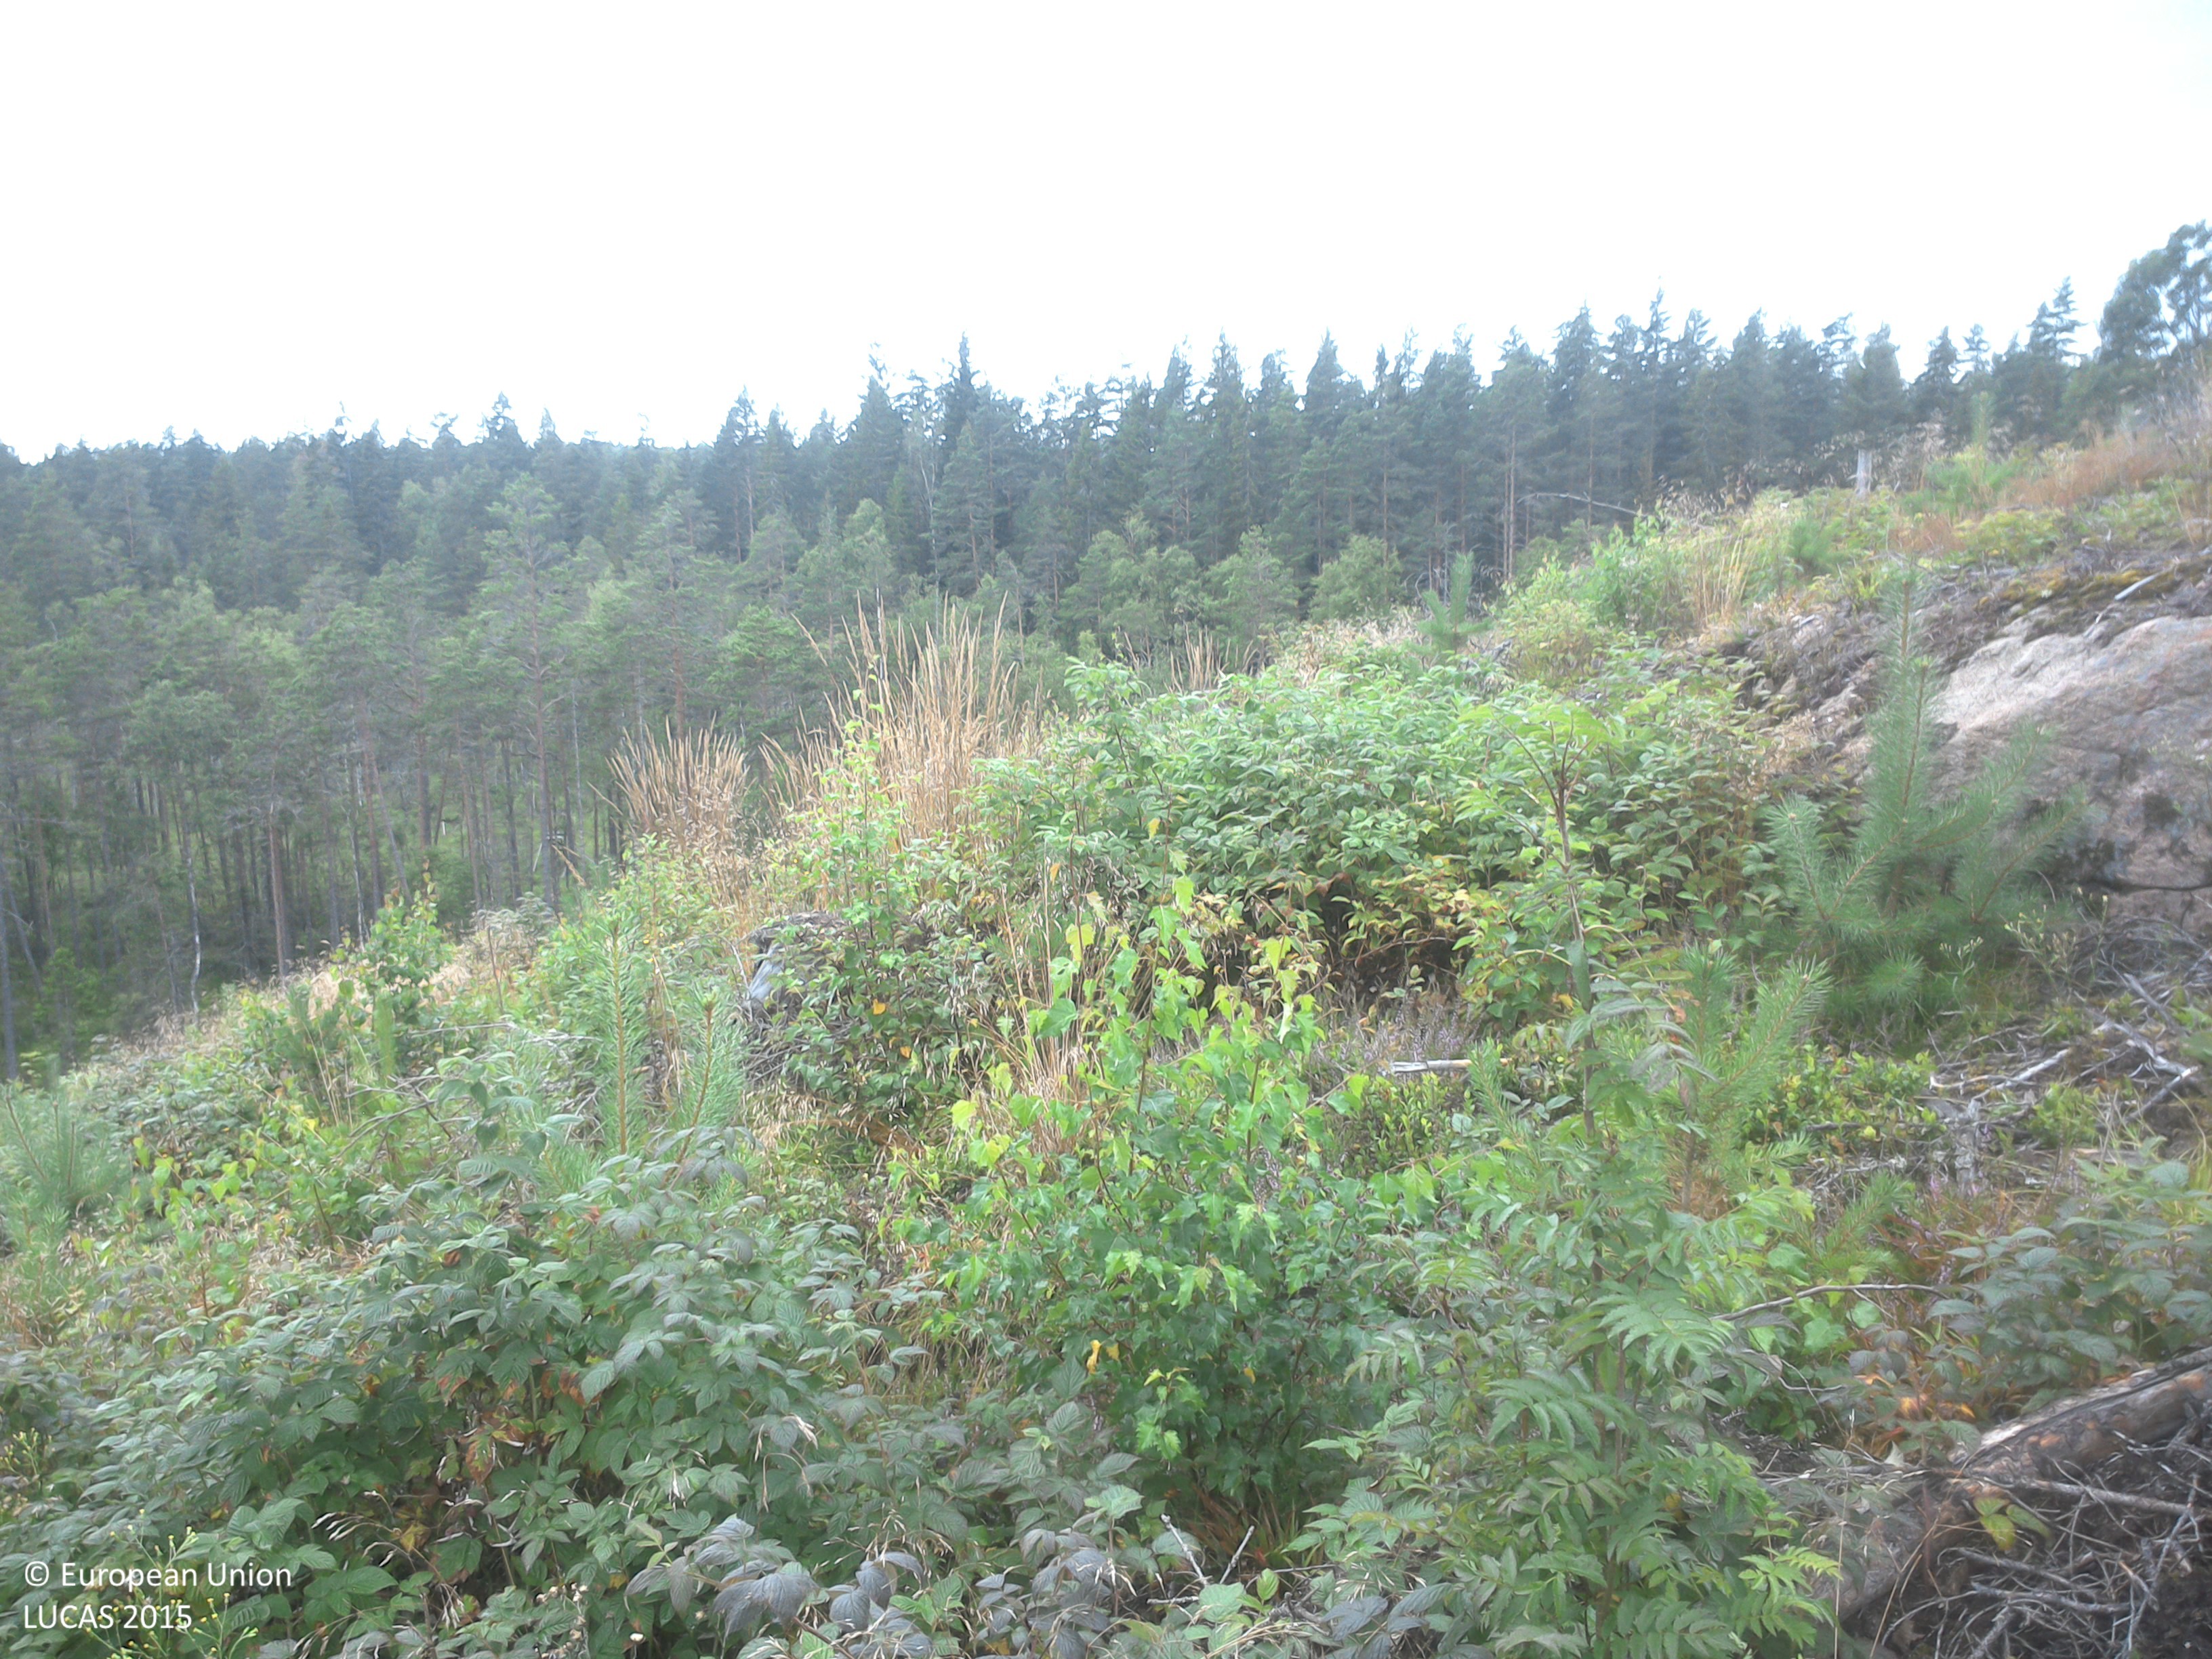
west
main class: Shrubland
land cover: Shrubland with sparse tree cover
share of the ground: 50 - 75 %
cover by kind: shrubs 60 %, herbaceous plants 35 %, coniferous forest trees 5 %
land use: Forestry
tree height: < 5 m
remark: Clear cut
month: August
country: SE
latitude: 57.7191
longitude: 15.2841
